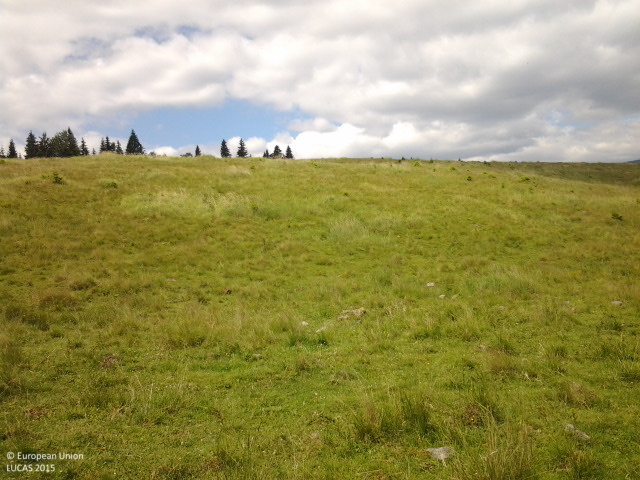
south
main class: Grassland
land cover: Grassland without tree/shrub cover
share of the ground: > 75 %
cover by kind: herbaceous plants 100 %
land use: Agriculture (excluding fallow land and kitchen gardens)
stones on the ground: 10 - 25 %
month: June
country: RO
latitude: 47.0501
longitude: 25.3392
